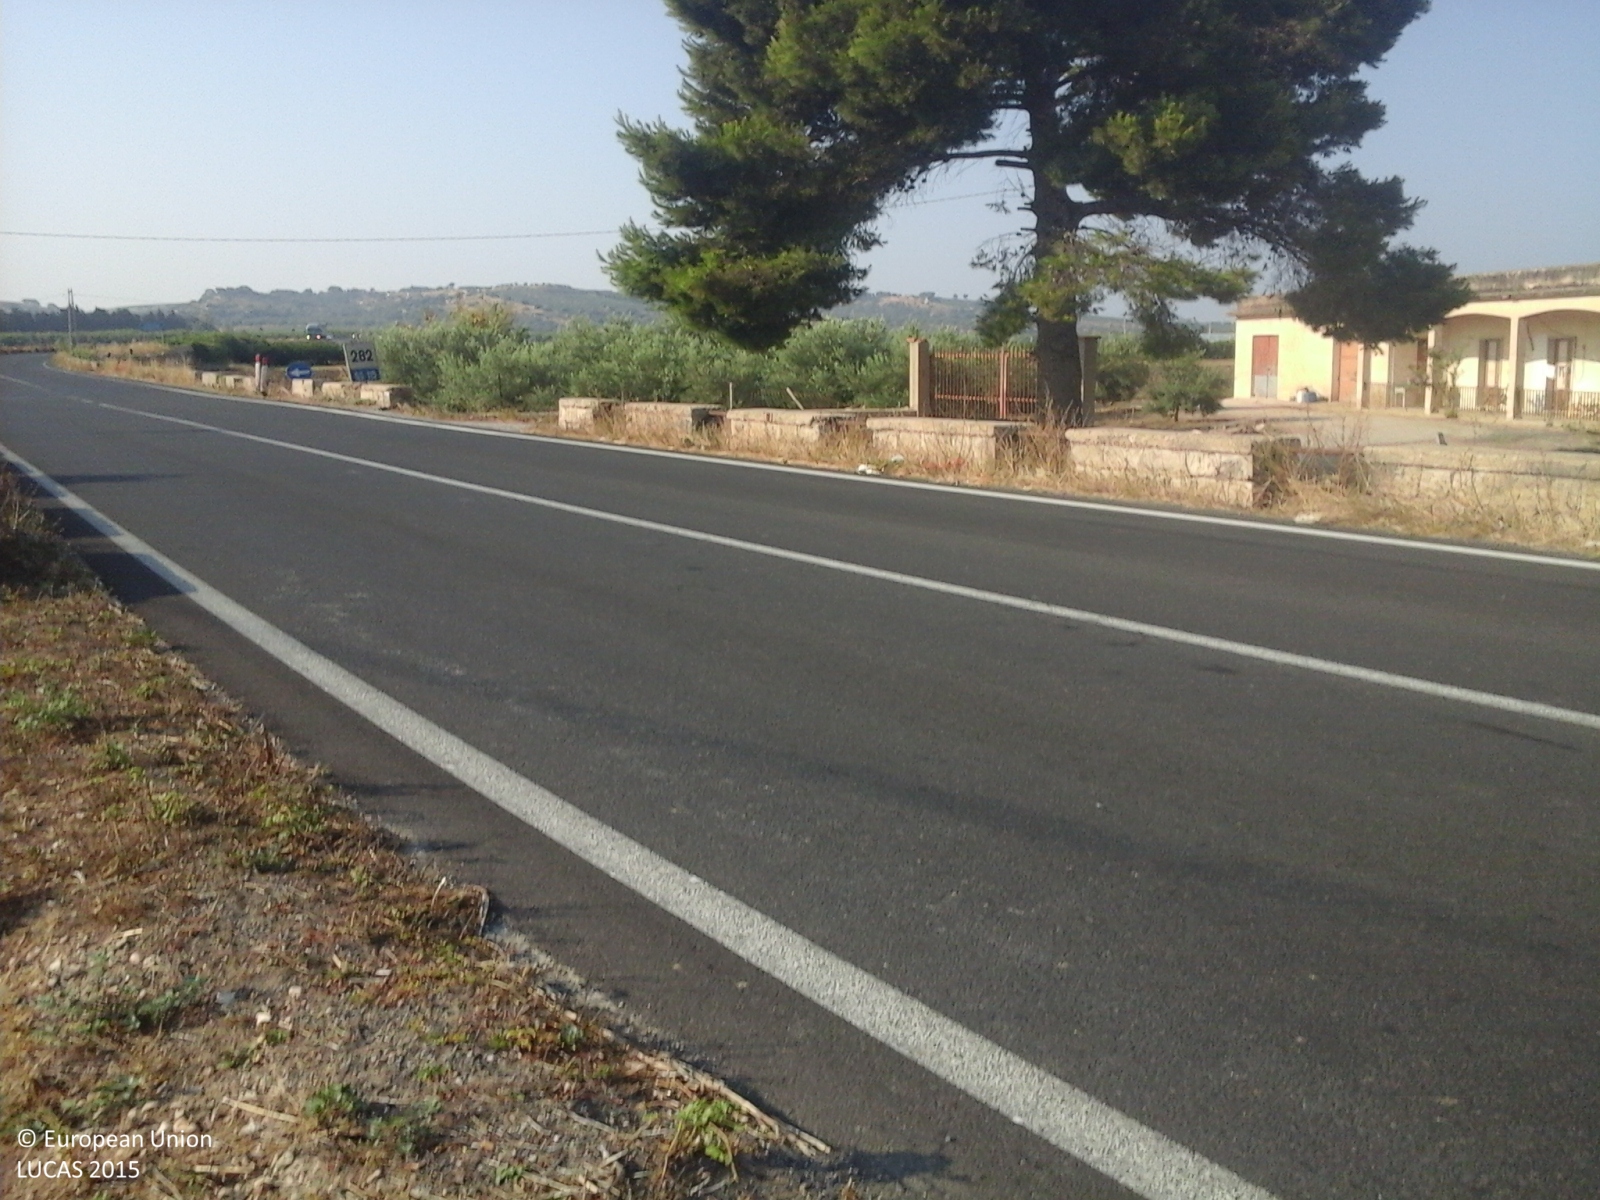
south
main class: Cropland
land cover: Durum wheat
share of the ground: > 75 %
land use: Agriculture (excluding fallow land and kitchen gardens)
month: July
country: IT
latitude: 37.0272
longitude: 14.4053
